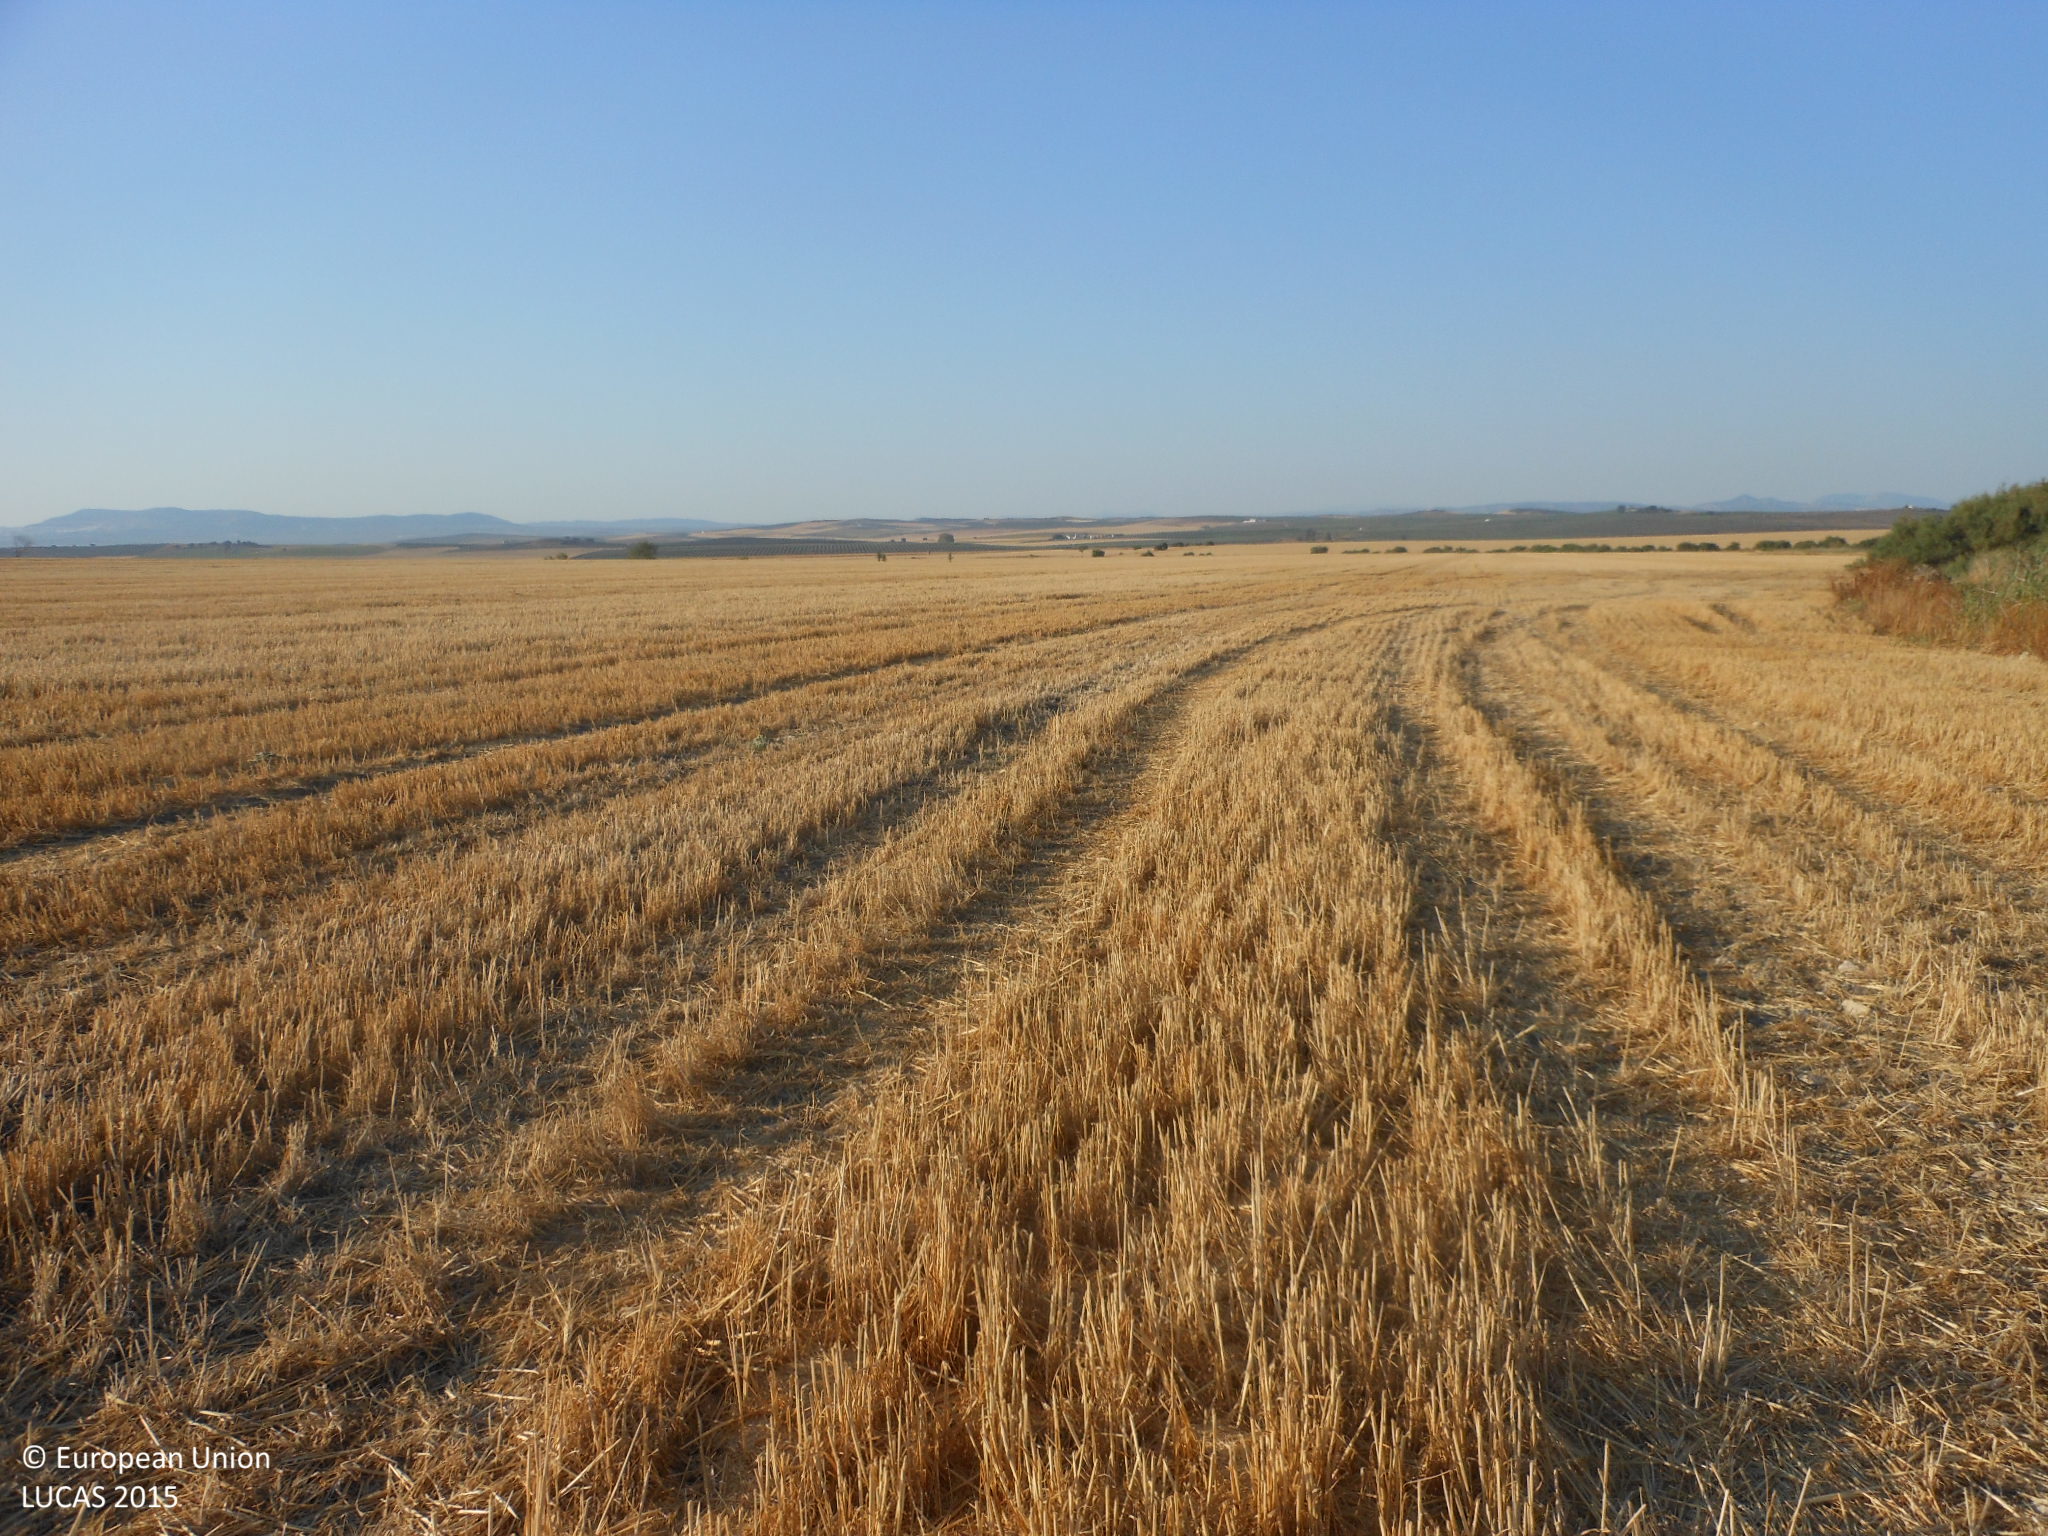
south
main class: Cropland
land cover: Durum wheat
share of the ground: < 10 %
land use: Agriculture (excluding fallow land and kitchen gardens)
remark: Harvested field
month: June
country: ES
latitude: 37.4399
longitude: -5.0770
